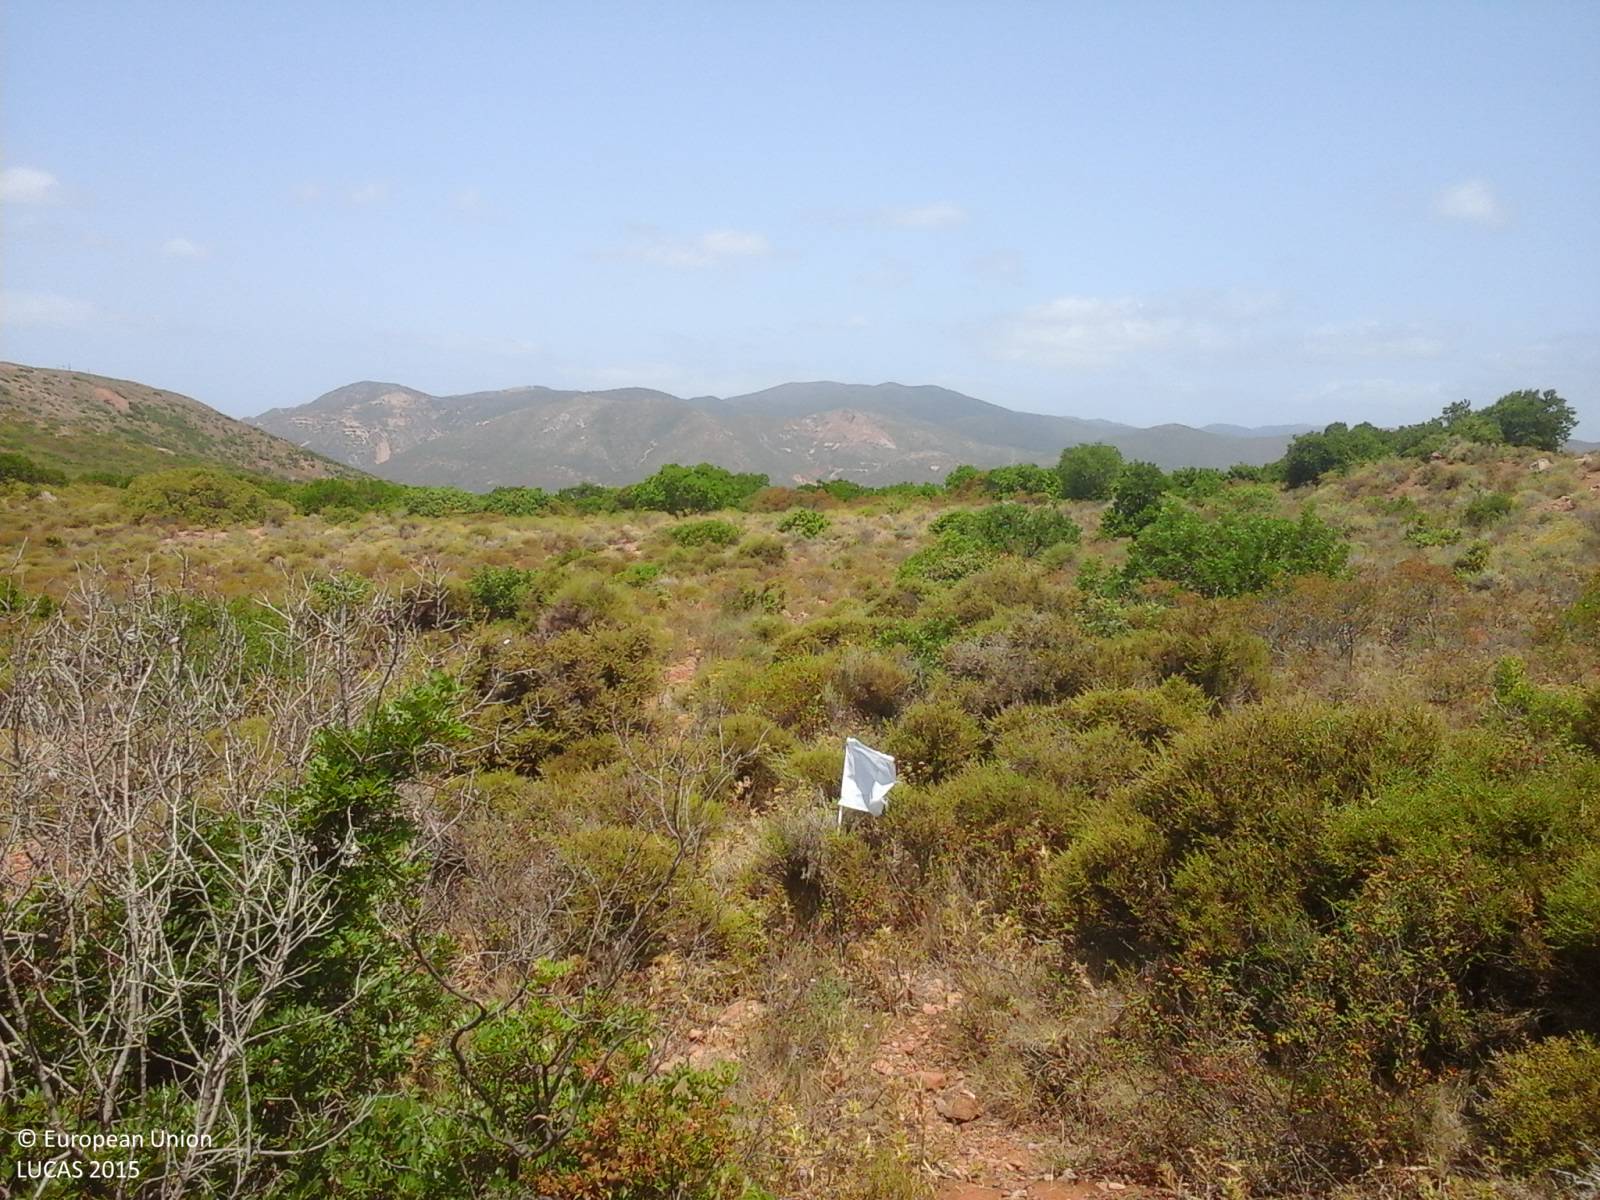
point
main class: Shrubland
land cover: Shrubland without tree cover
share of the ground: > 75 %
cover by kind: shrubs 65 %, unconsolidated bare surface 15 %, herbaceous plants 10 %, consolidated bare surface 10 %
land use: Semi-natural and natural areas not in use
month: July
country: IT
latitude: 39.2779
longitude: 8.5137
